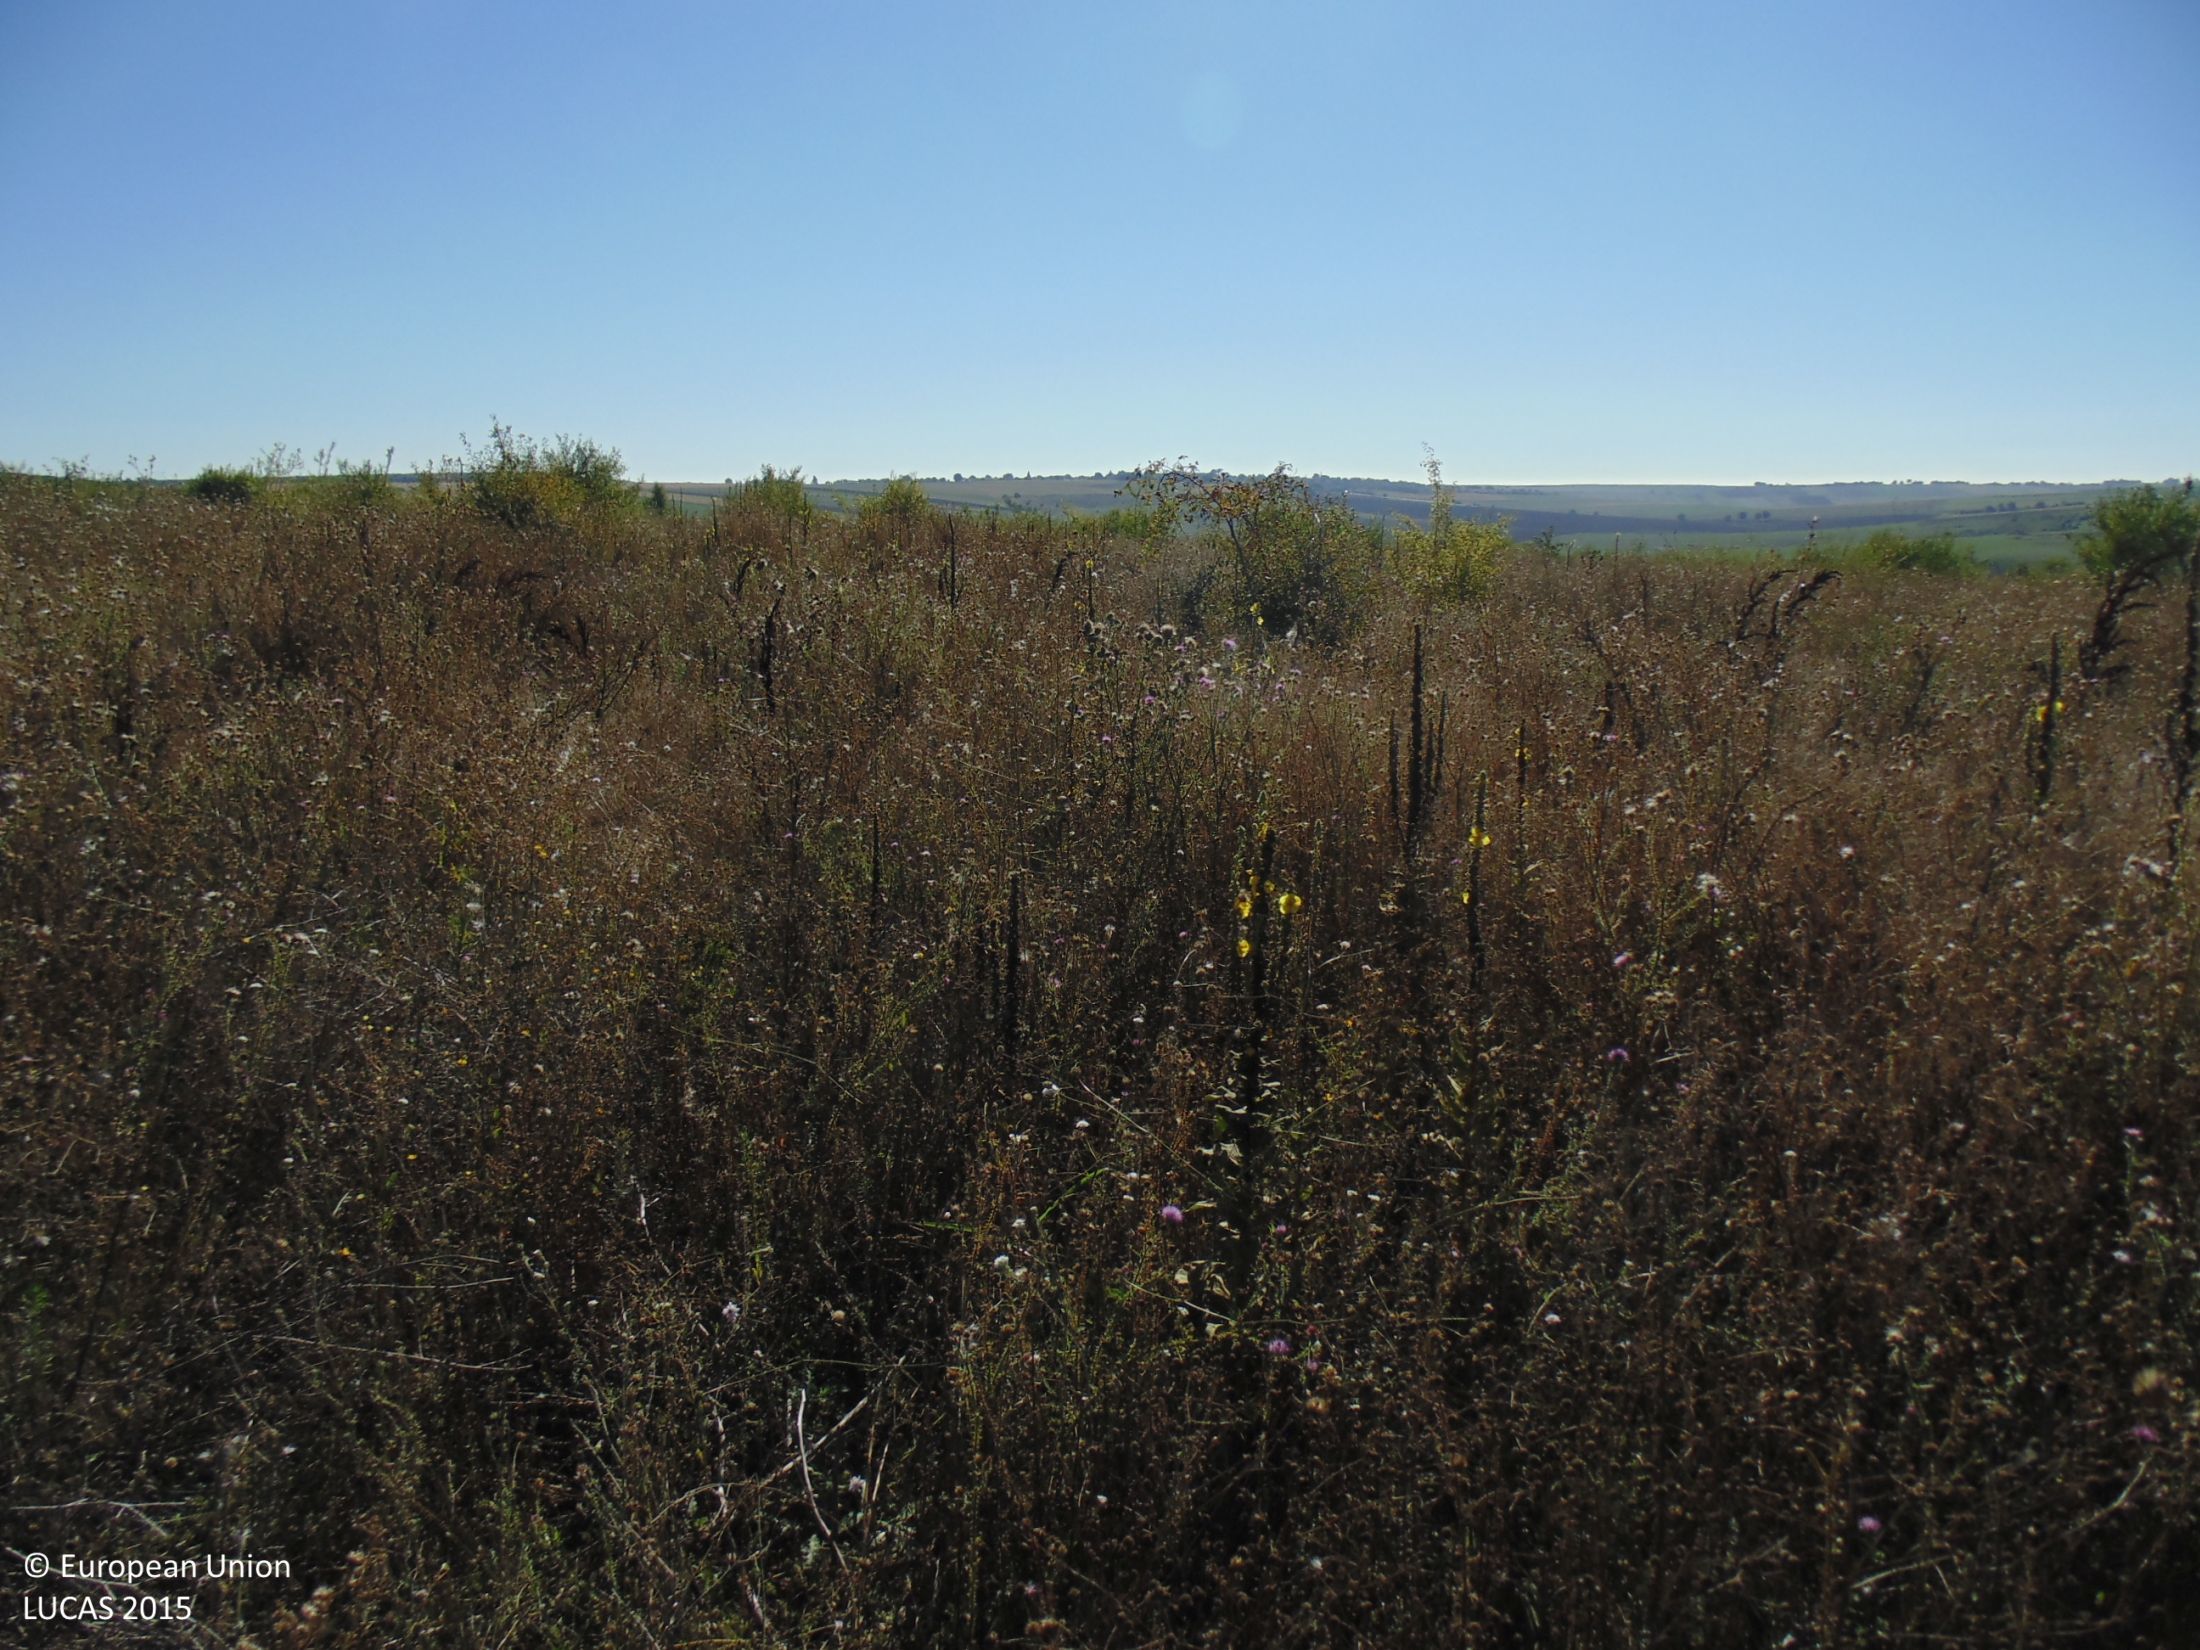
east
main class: Grassland
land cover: Grassland with sparse tree/shrub cover
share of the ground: > 75 %
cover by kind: herbaceous plants 90 %, broadleaved forest trees 5 %, shrubs 5 %
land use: Abandoned areas
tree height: < 5 m
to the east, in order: Grassland with sparse tree/shrub cover; Tracks; Grassland with sparse tree/shrub cover; Sunflower
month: September
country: BG
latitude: 43.7870
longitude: 27.1874
